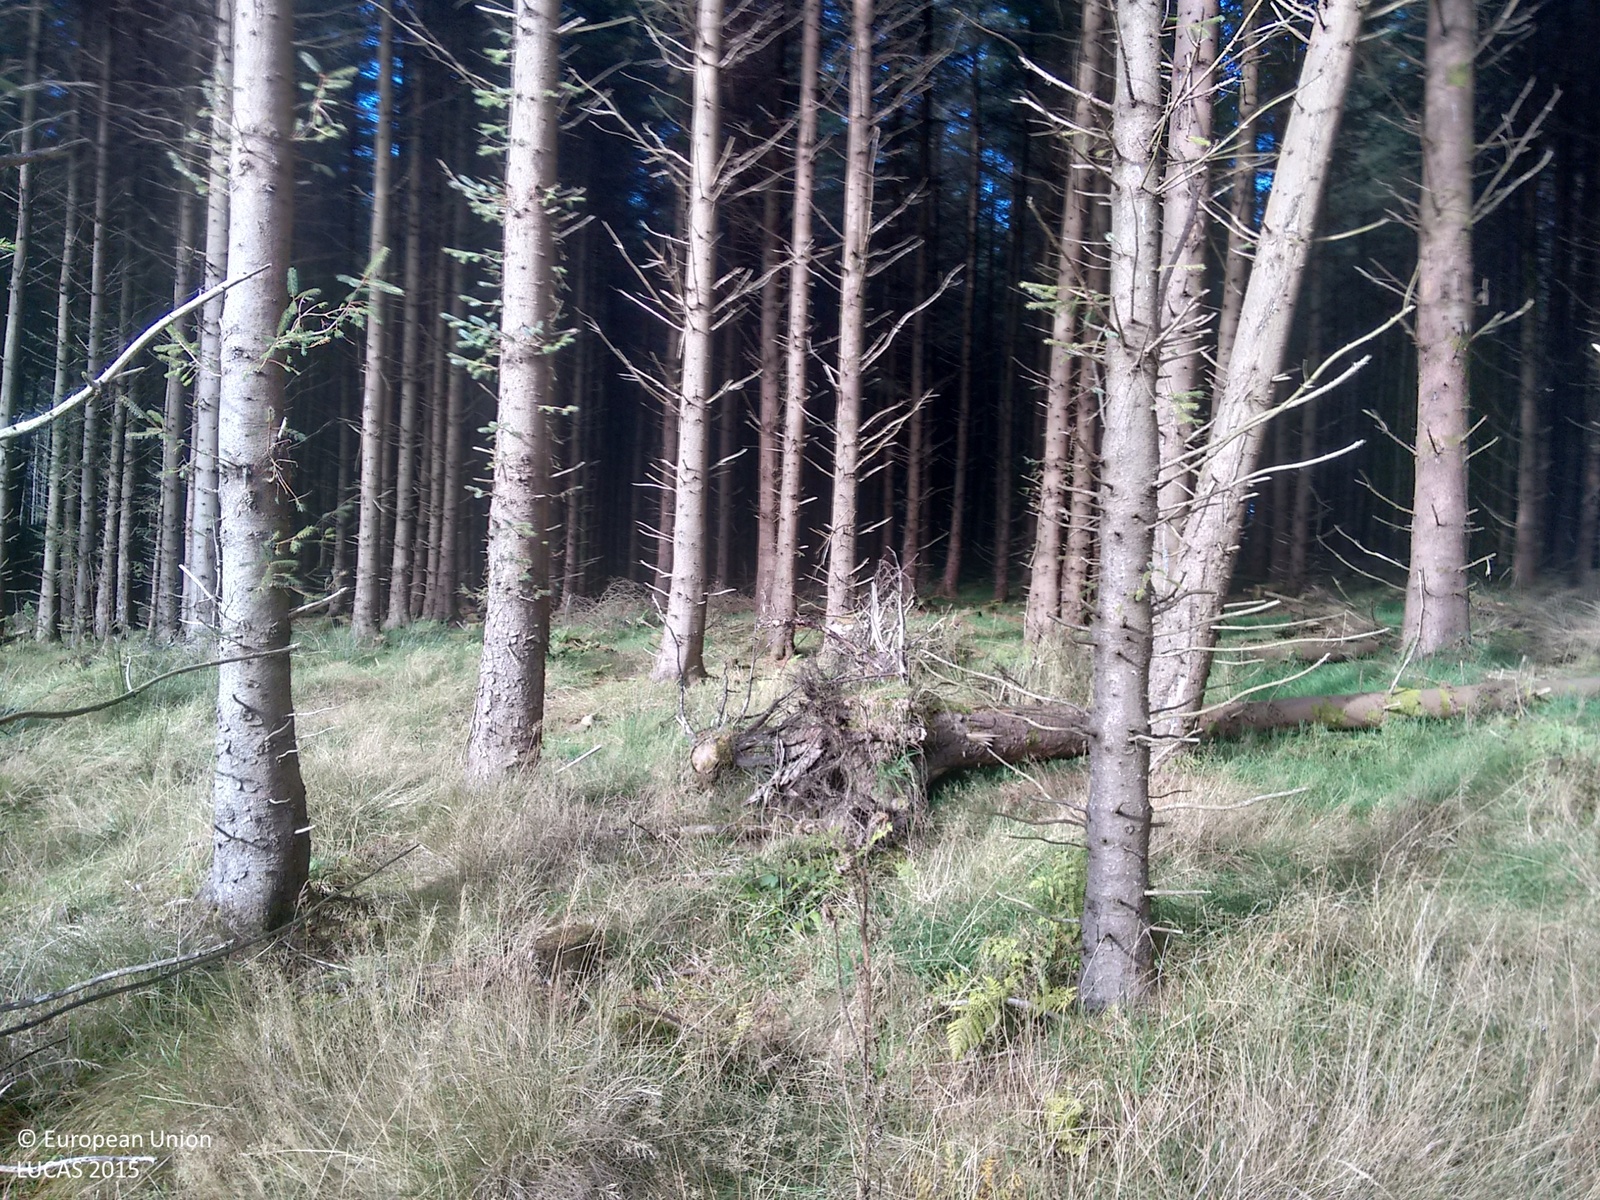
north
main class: Woodland
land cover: Spruce dominated coniferous woodland
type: exotic forest
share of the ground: > 75 %
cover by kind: coniferous forest trees 65 %, herbaceous plants 35 %
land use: Forestry
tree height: > 5 m
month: October
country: IE
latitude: 52.9905
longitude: -7.6686
